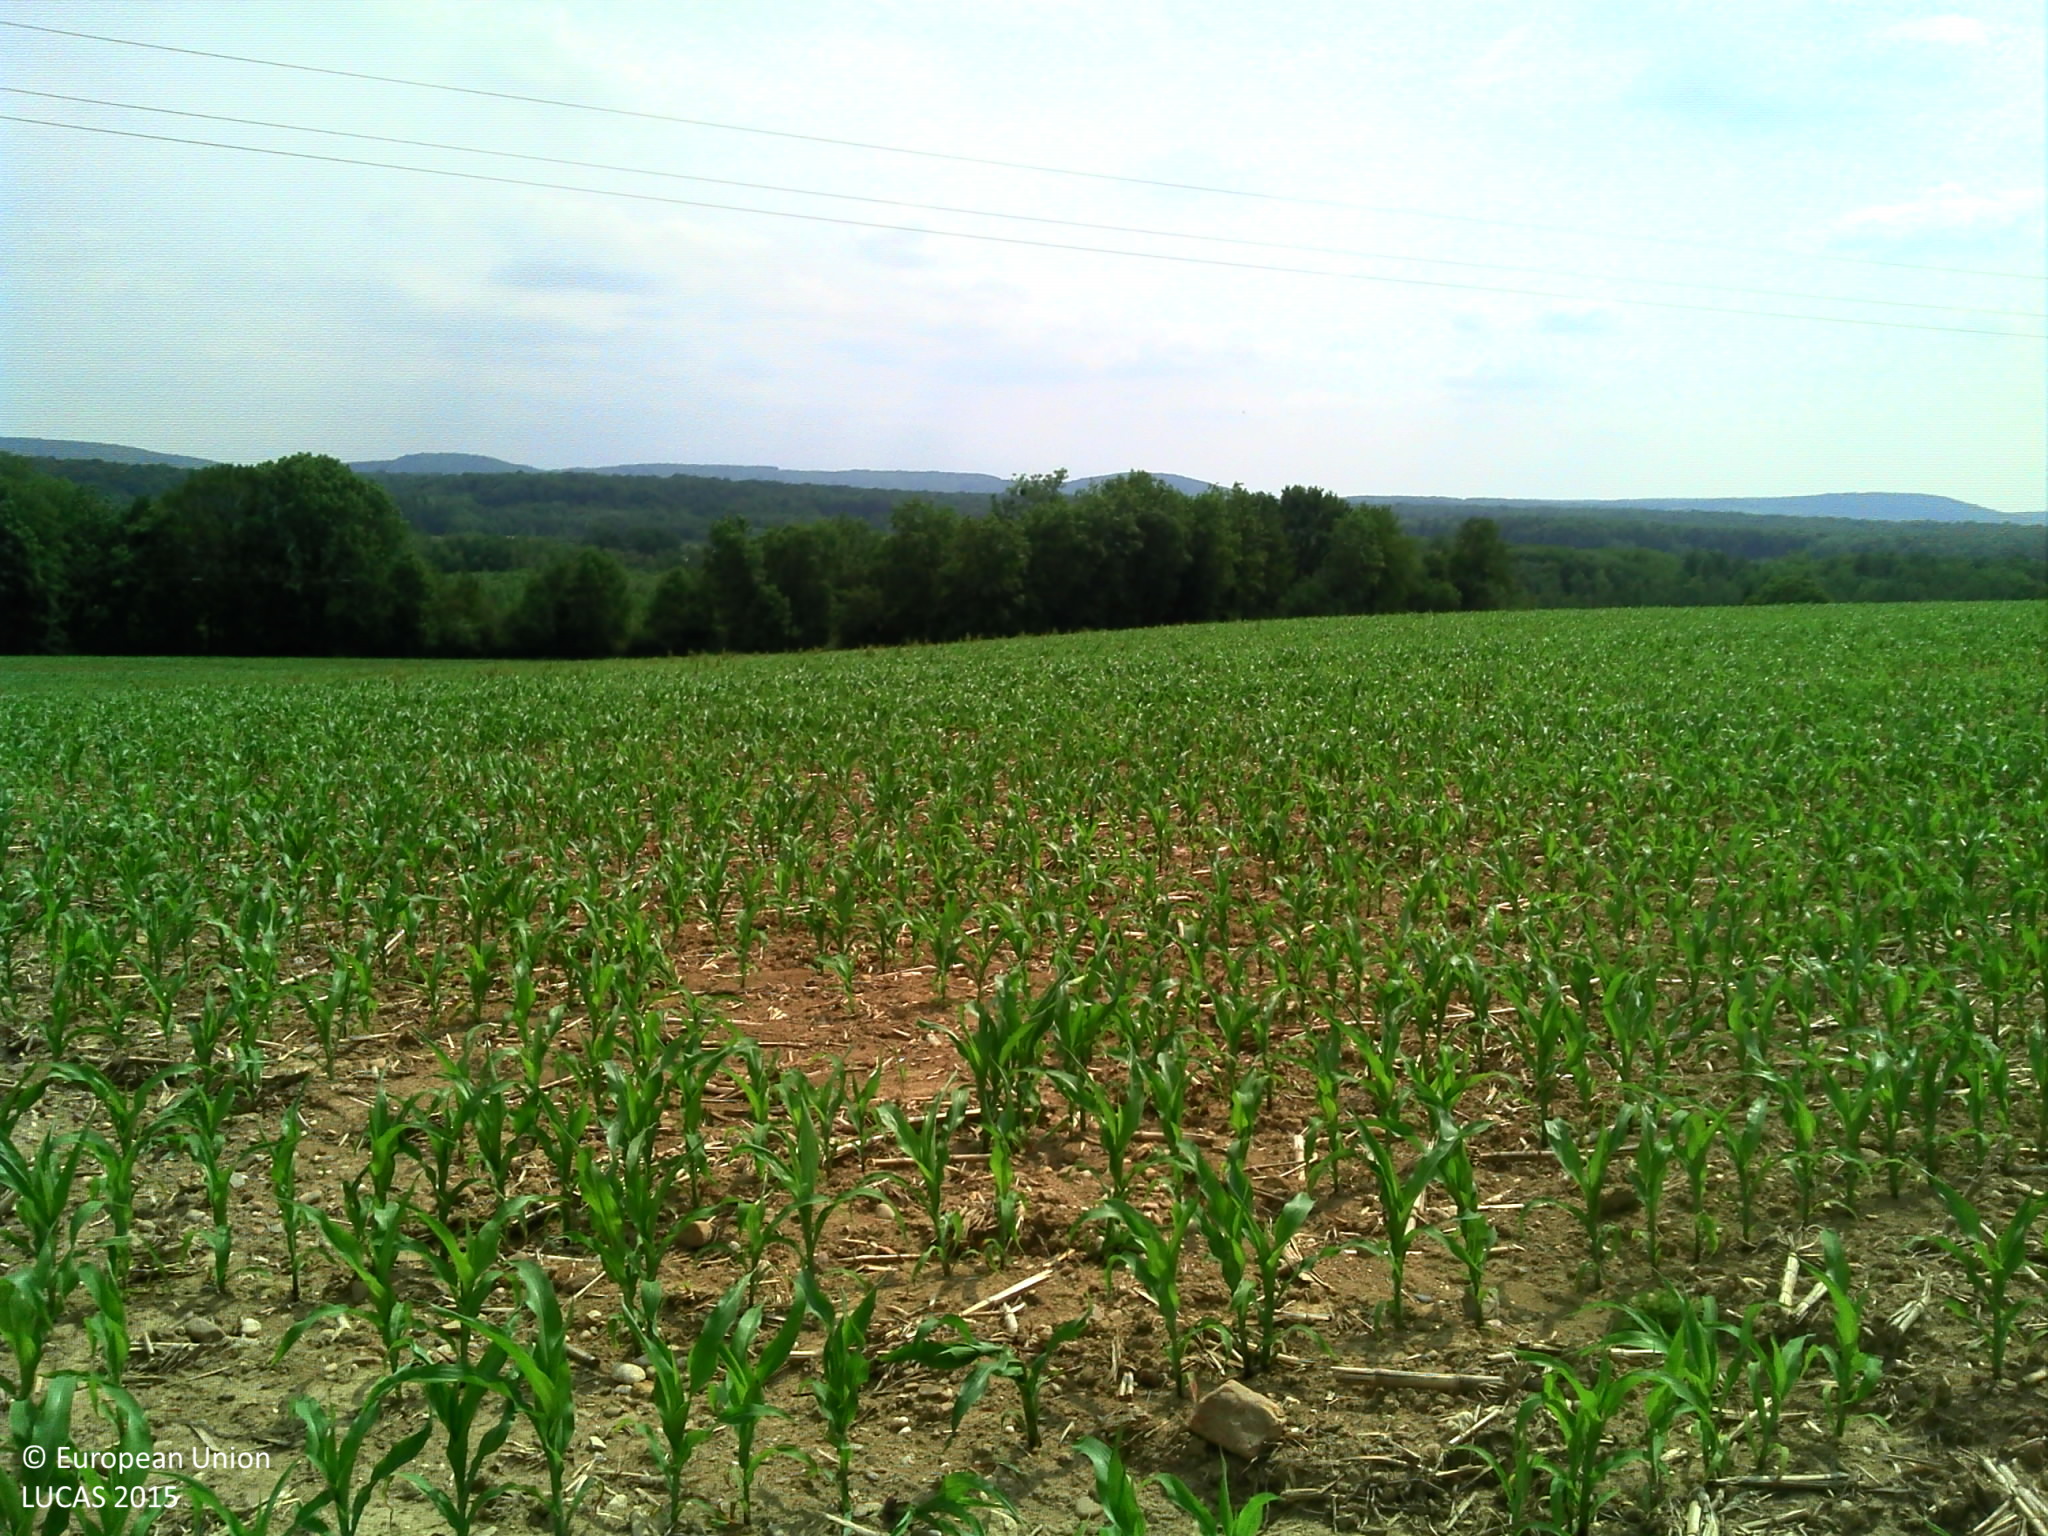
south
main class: Cropland
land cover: Maize
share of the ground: 50 - 75 %
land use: Agriculture (excluding fallow land and kitchen gardens)
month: June
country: FR
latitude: 47.8165
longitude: 6.2214
